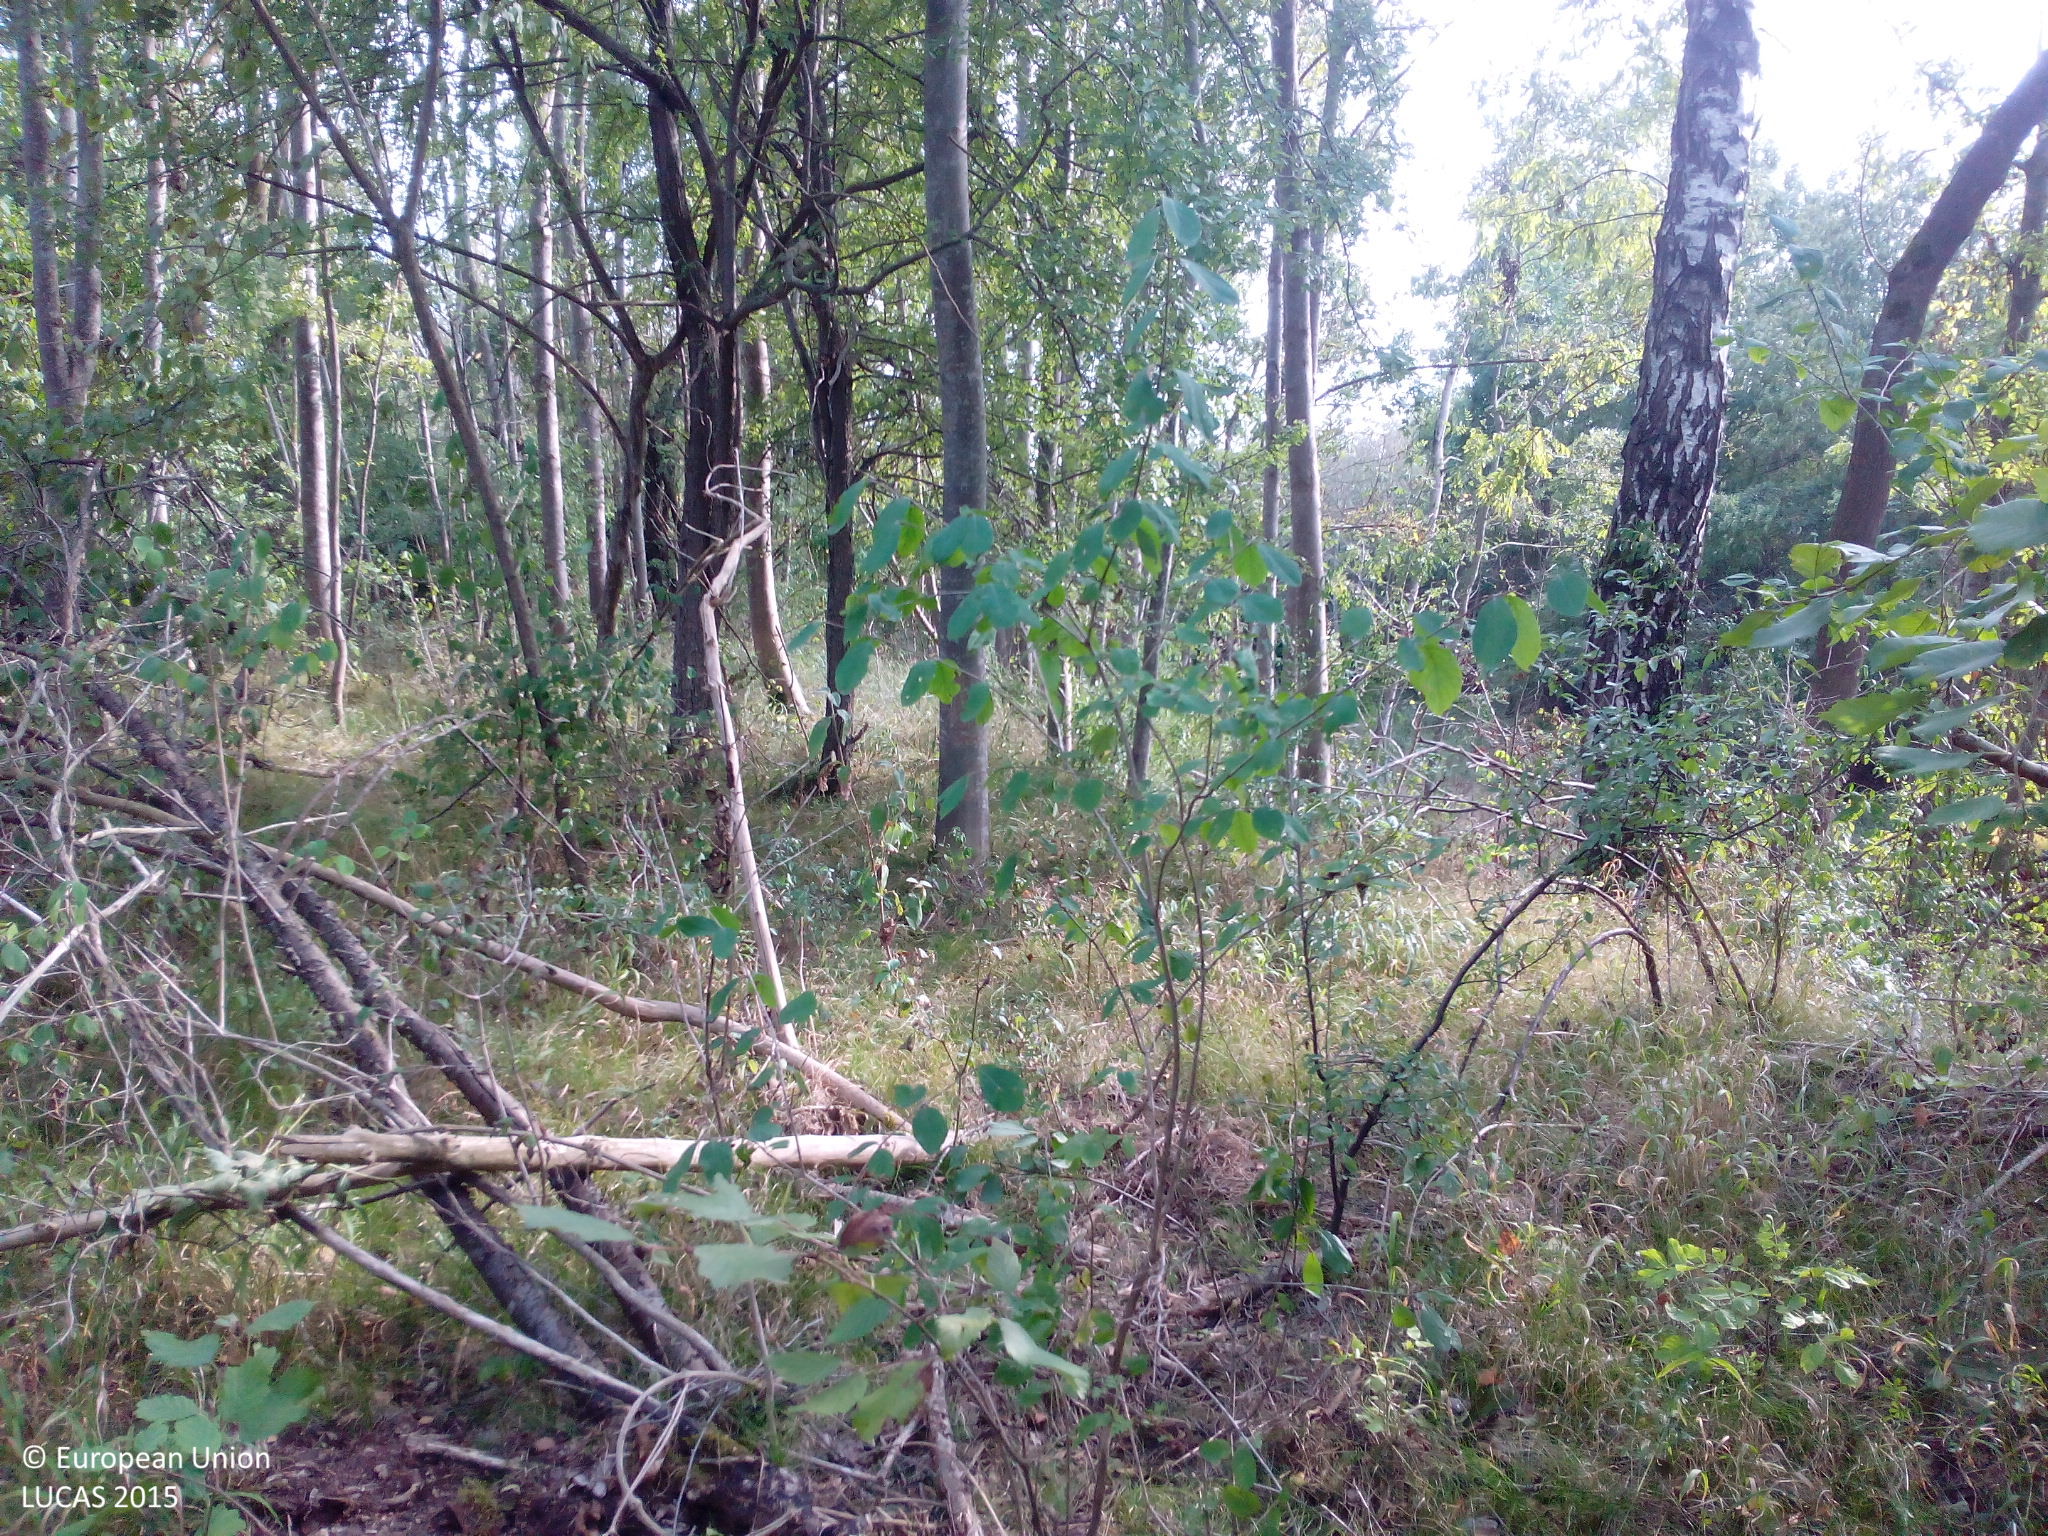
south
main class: Woodland
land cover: Broadleaved woodland
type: mesophytic deciduous forest
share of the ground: > 75 %
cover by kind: broadleaved forest trees 80 %, shrubs 10 %, herbaceous plants 10 %
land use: Protection infrastructures
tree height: > 5 m
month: September
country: DE
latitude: 48.4720
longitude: 10.8787
